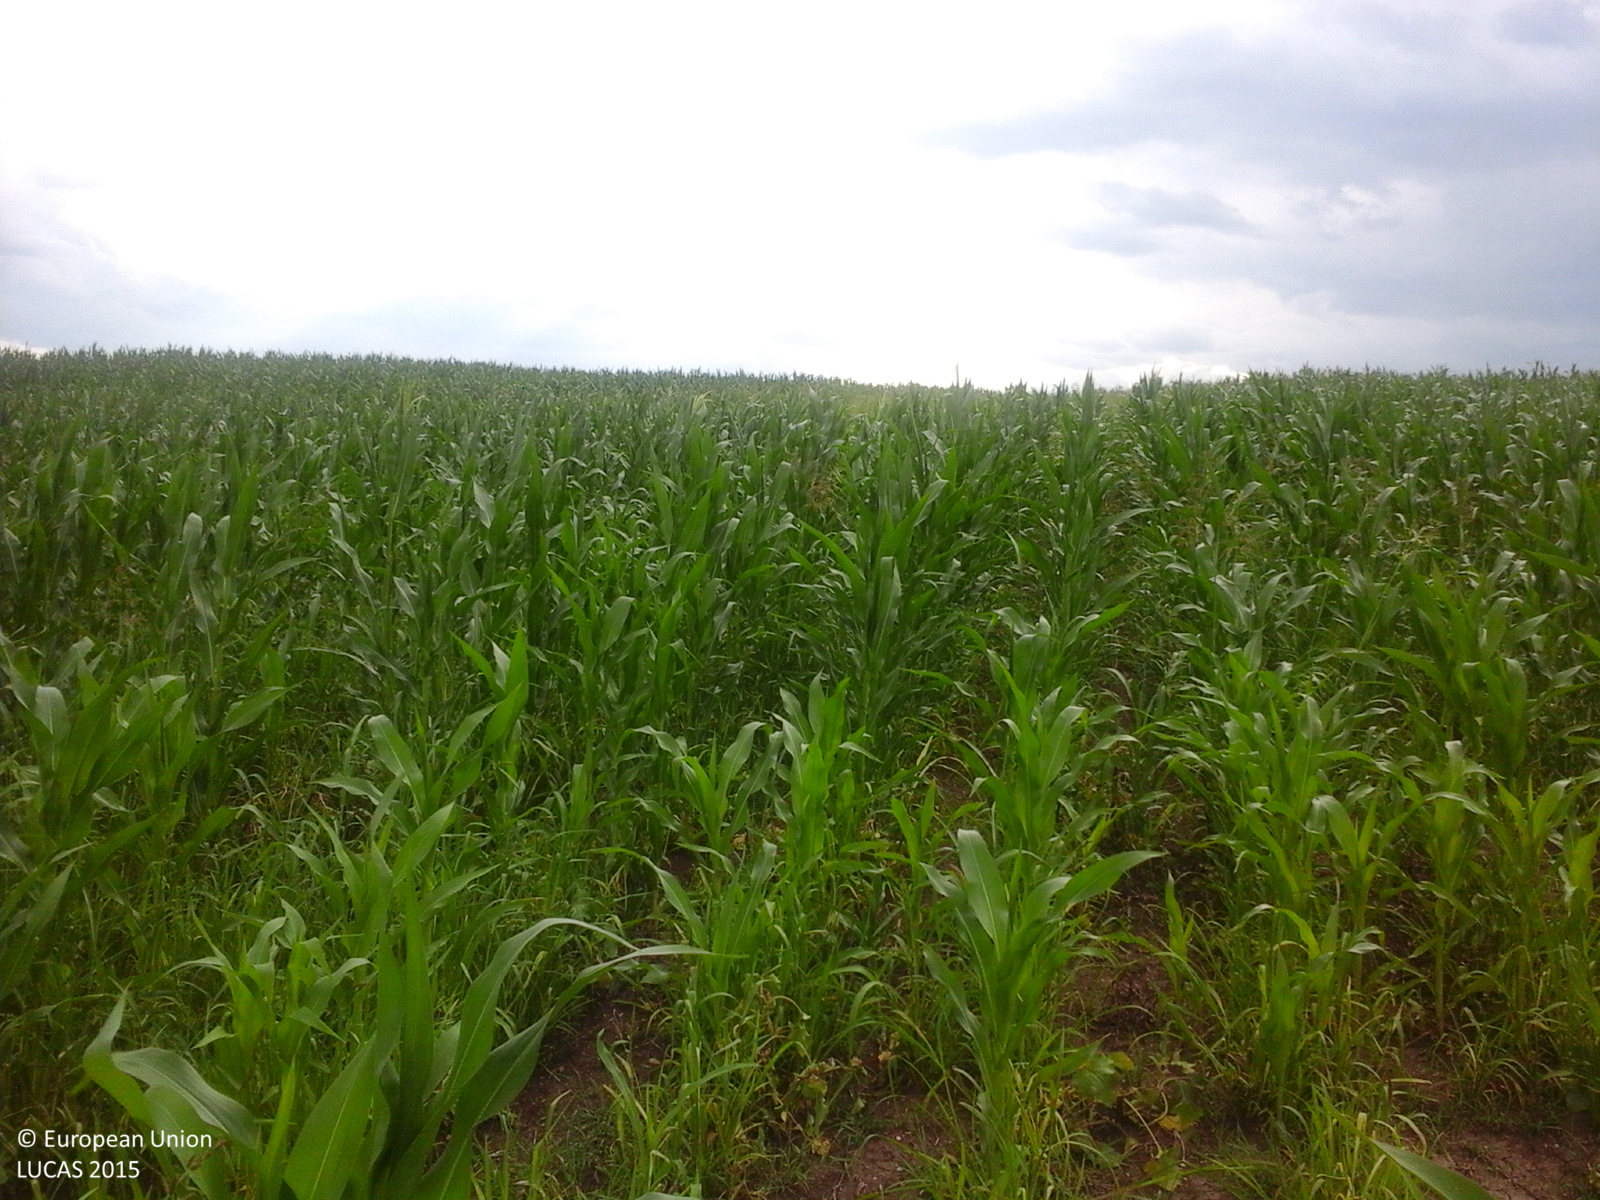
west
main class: Cropland
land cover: Maize
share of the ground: > 75 %
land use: Agriculture (excluding fallow land and kitchen gardens)
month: July
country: RO
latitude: 44.4375
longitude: 24.9163
